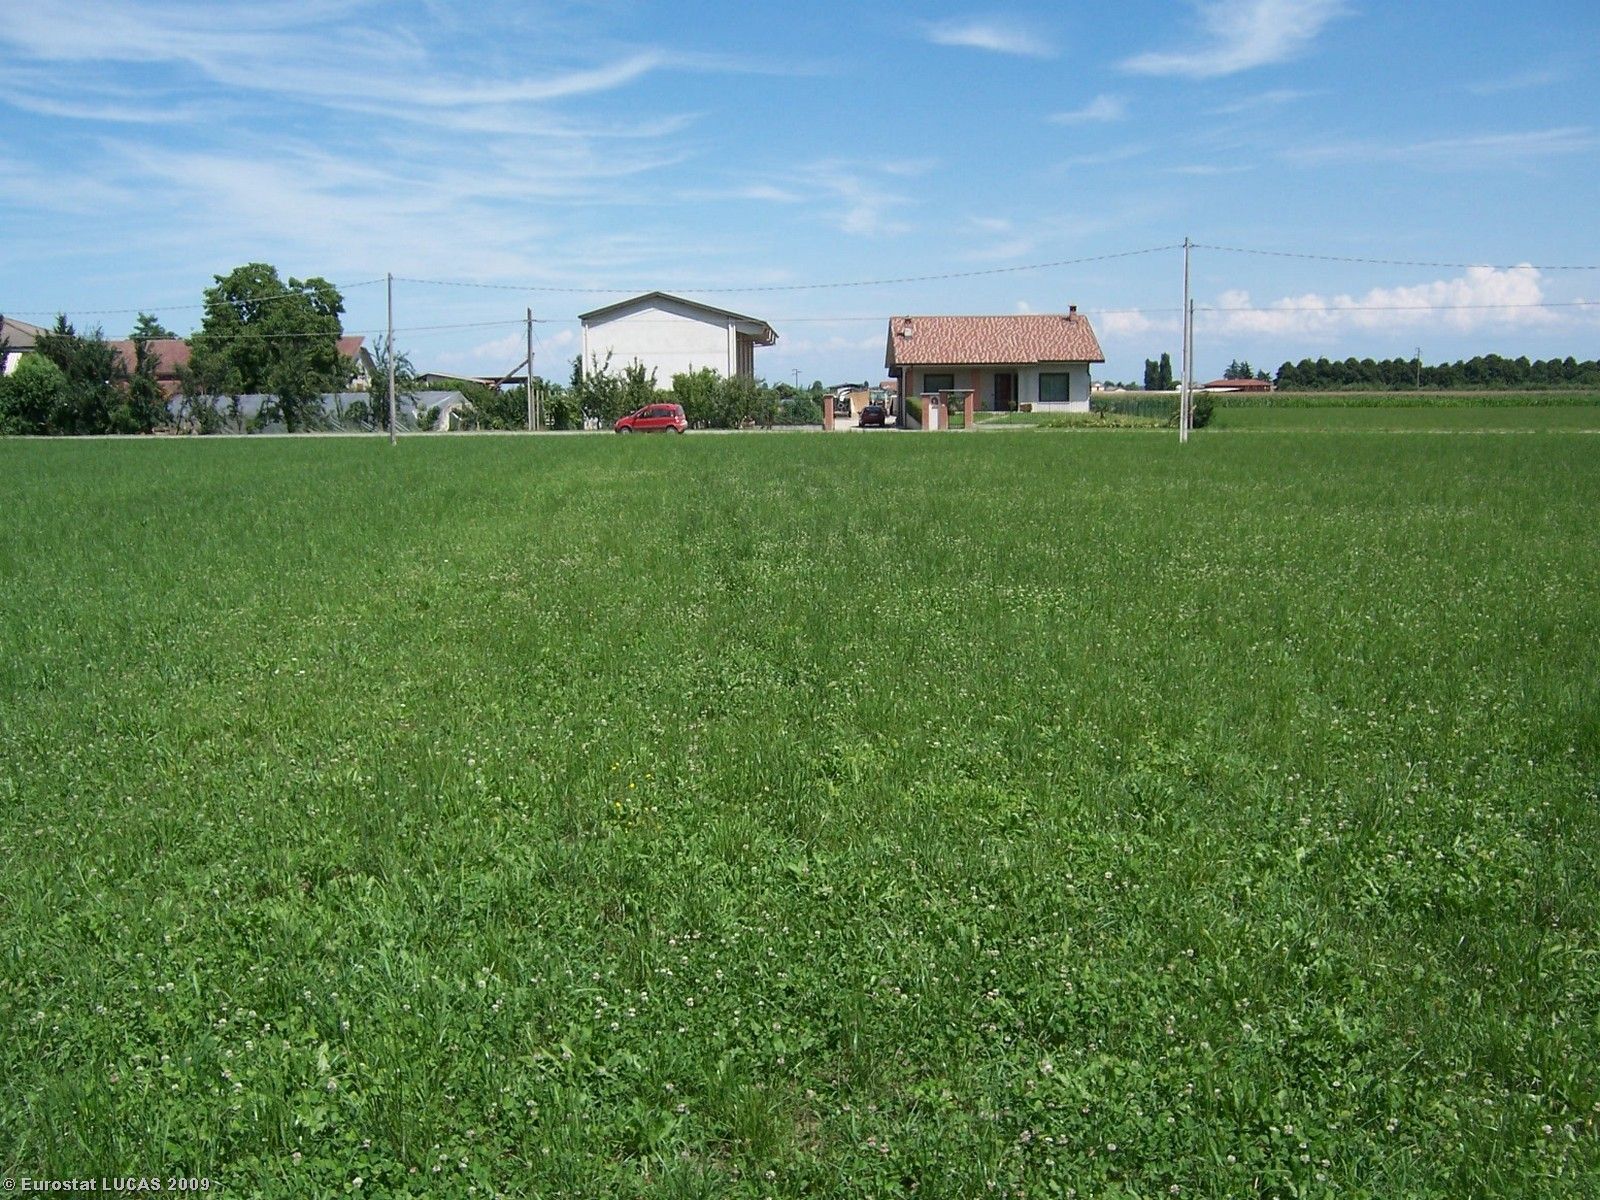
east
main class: Cropland
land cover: Maize
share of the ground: > 75 %
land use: Agriculture (excluding fallow land and kitchen gardens)
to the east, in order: Maize; Ditches and canals; Grassland without tree/shrub cover; Electric lines; Grassland without tree/shrub cover; Paved roads, cycling and walking lanes; Grass margins; Ditches and canals; Electric lines; Grass margins; Apple fruit; Grassland with sparse tree/shrub cover; Artificial constructions in urban areas; Grassland without tree/shrub cover
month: July
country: IT
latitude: 44.8048
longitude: 7.3877
